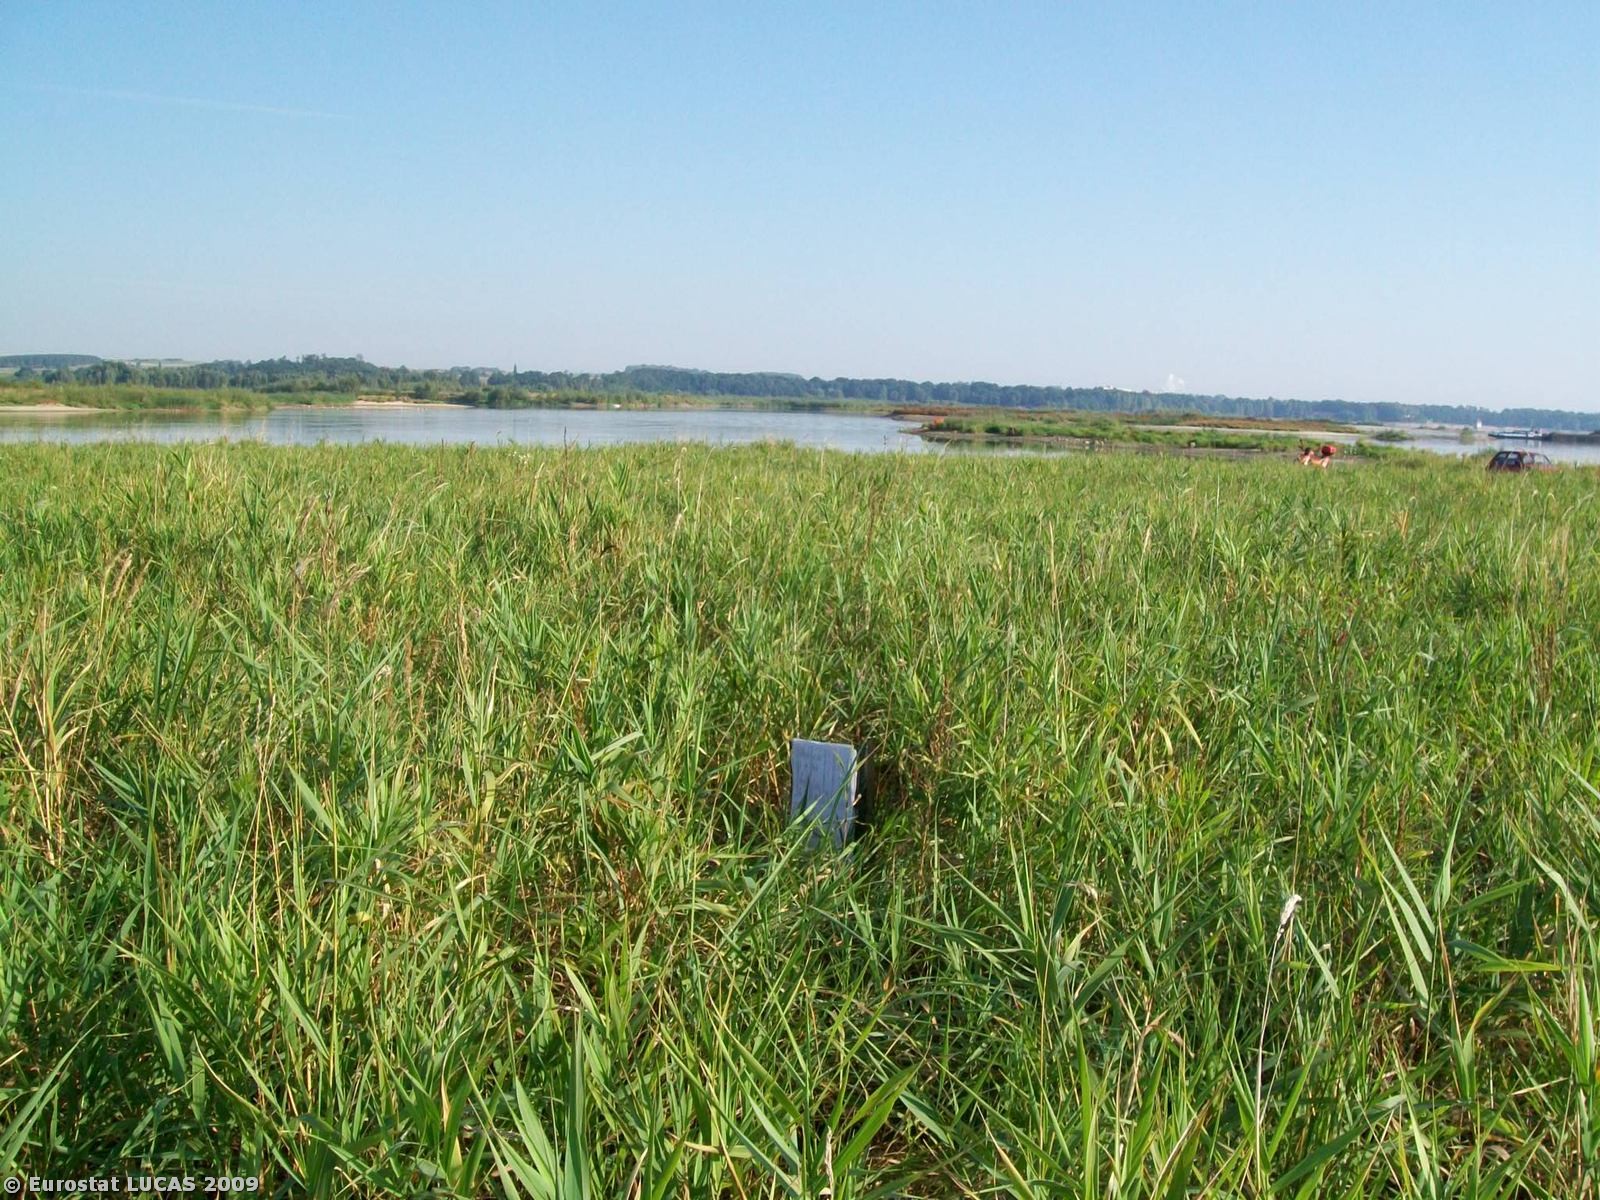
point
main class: Grassland
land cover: Grassland without tree/shrub cover
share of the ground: > 75 %
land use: Unused
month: September
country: PL
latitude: 50.4418
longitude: 17.2347
